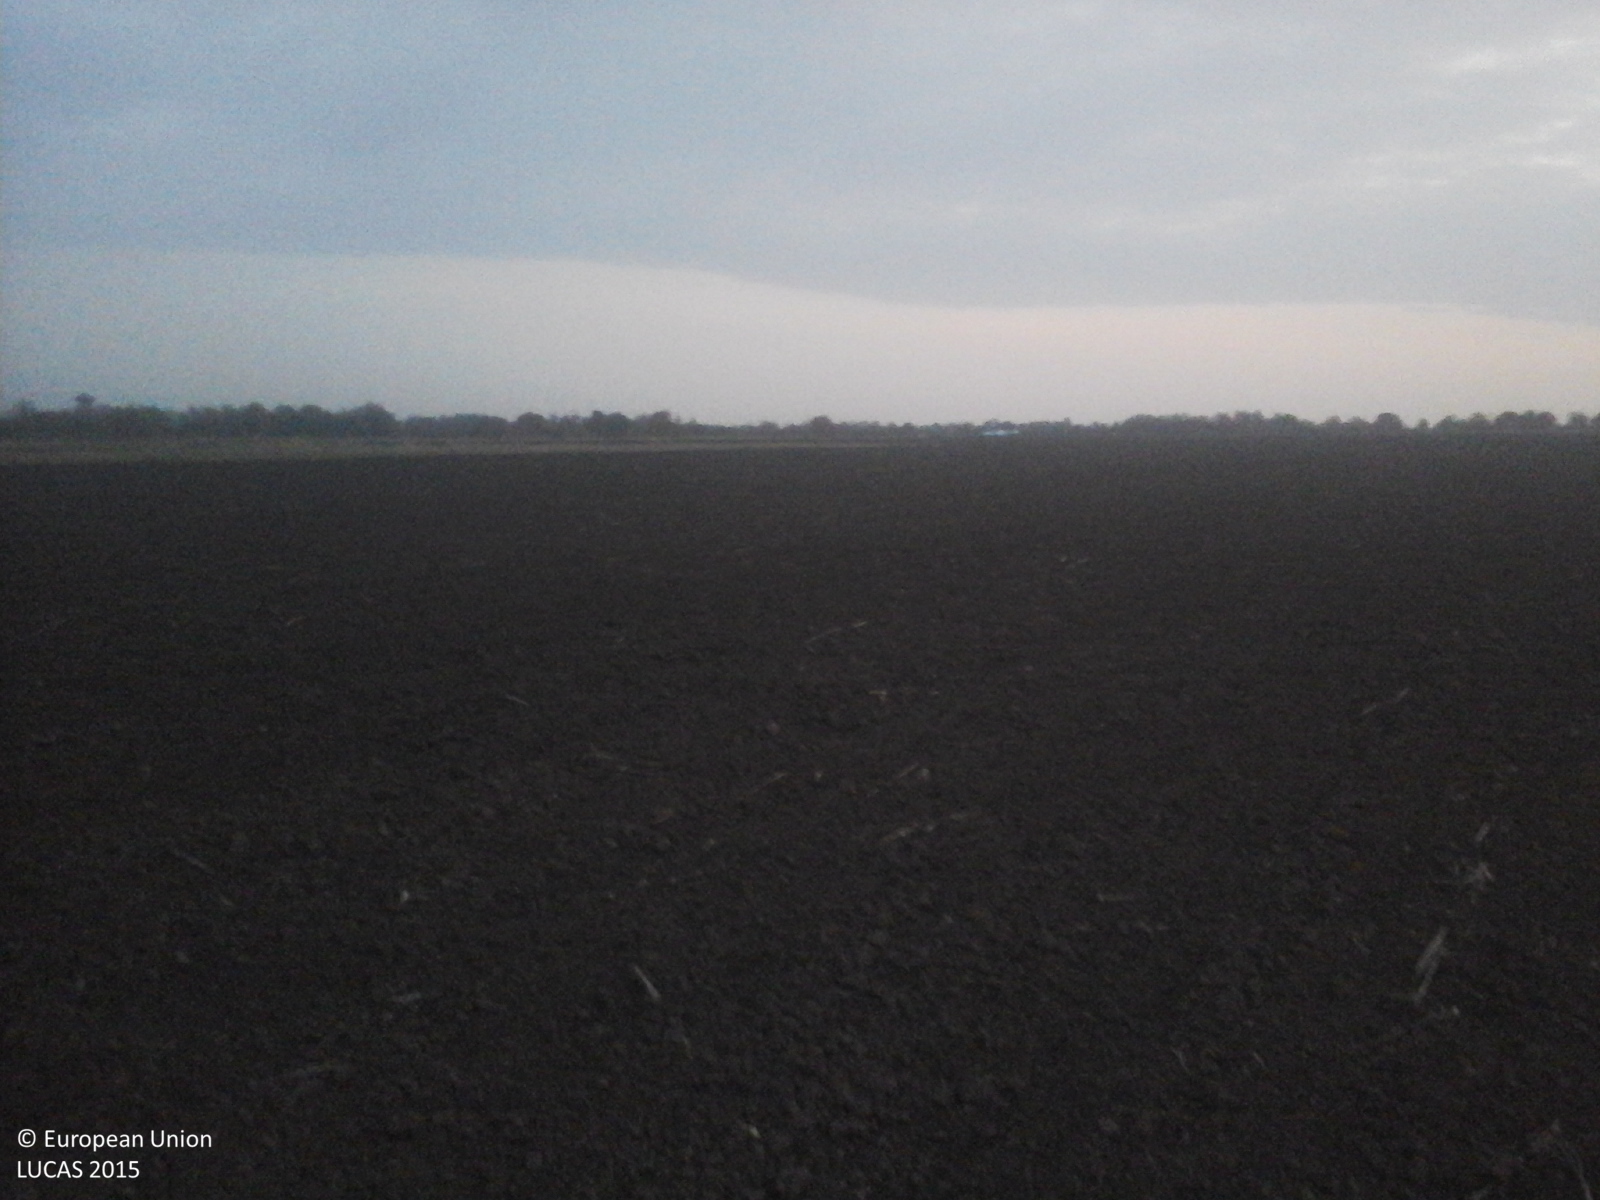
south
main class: Cropland
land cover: Maize
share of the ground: < 10 %
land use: Agriculture (excluding fallow land and kitchen gardens)
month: October
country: RO
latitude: 45.2892
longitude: 27.0057
